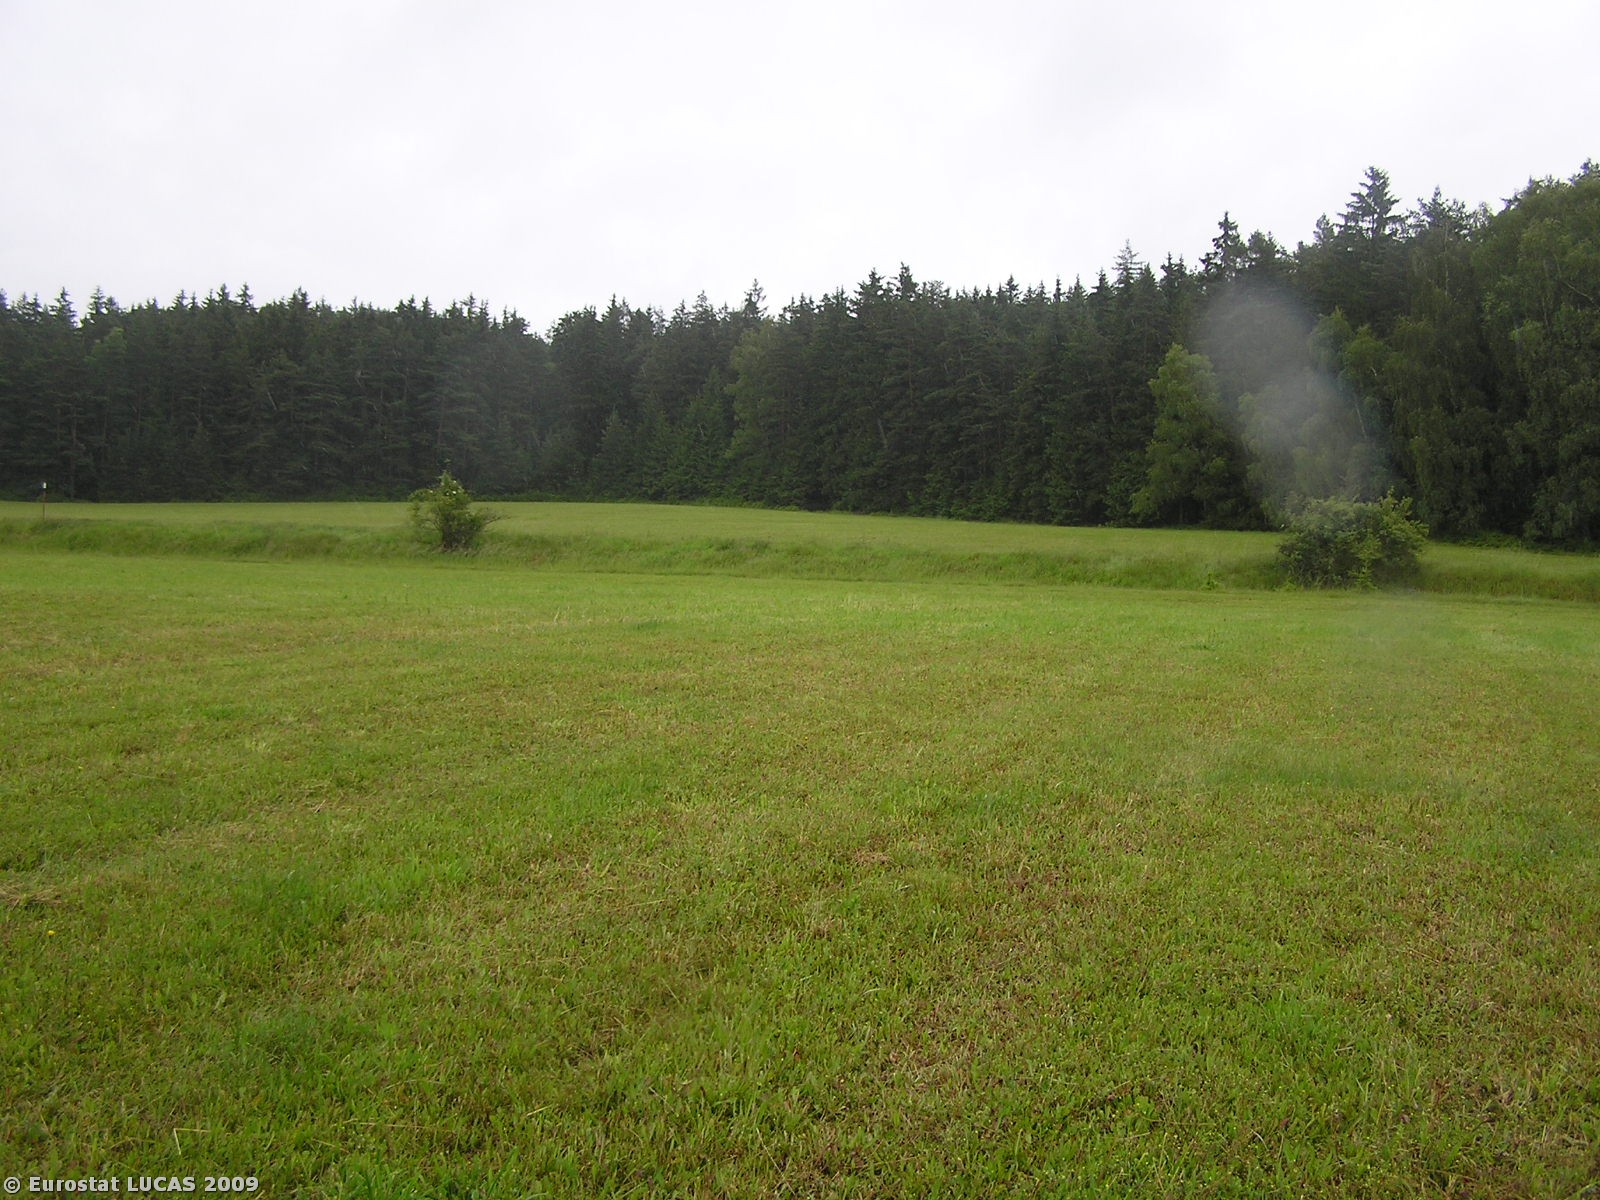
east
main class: Grassland
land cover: Grassland without tree/shrub cover
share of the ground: > 75 %
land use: Agriculture (excluding fallow land and kitchen gardens)
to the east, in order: Grassland without tree/shrub cover; Tracks; Grassland without tree/shrub cover; Coniferous woodland
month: June
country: CZ
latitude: 49.2474
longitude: 14.9613
